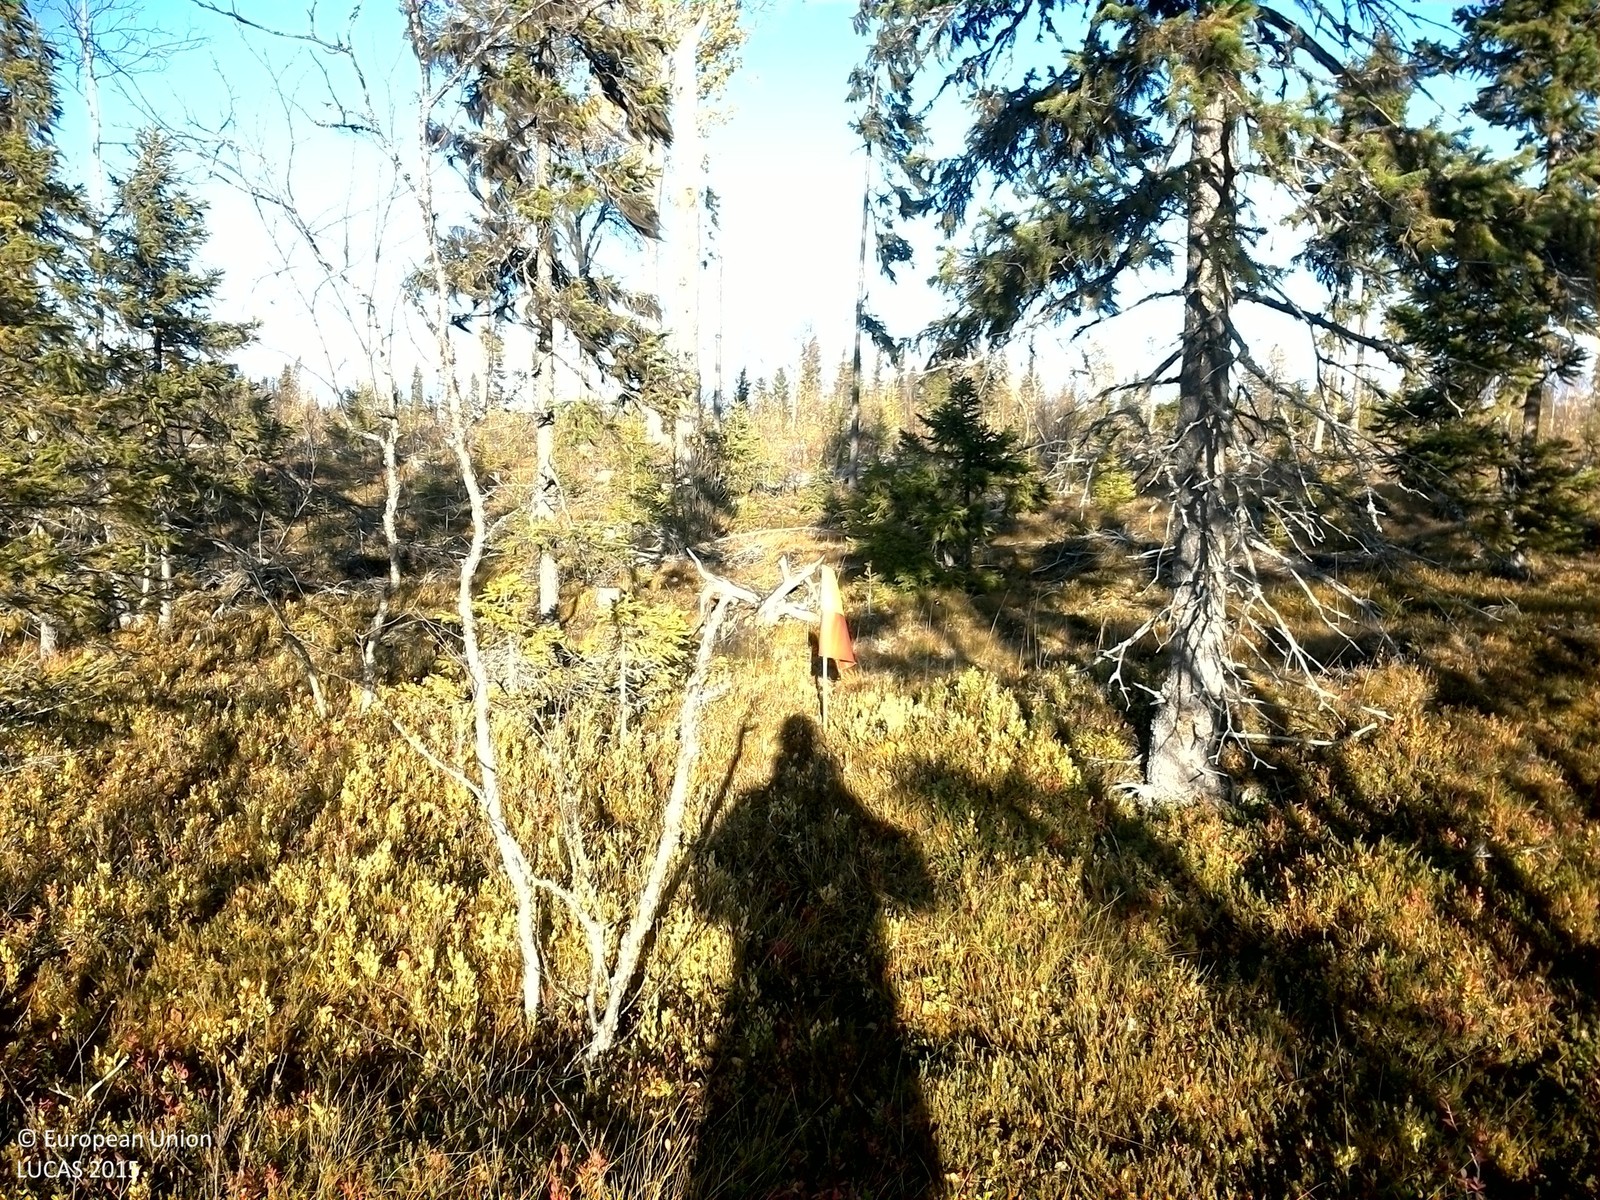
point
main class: Woodland
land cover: Spruce dominated mixed woodland
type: boreal forest
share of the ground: 25 - 50 %
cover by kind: shrubs 45 %, coniferous forest trees 25 %, broadleaved forest trees 15 %, lichens and mosses 15 %
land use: Forestry
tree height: > 5 m
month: October
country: SE
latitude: 64.1909
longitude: 16.0845
